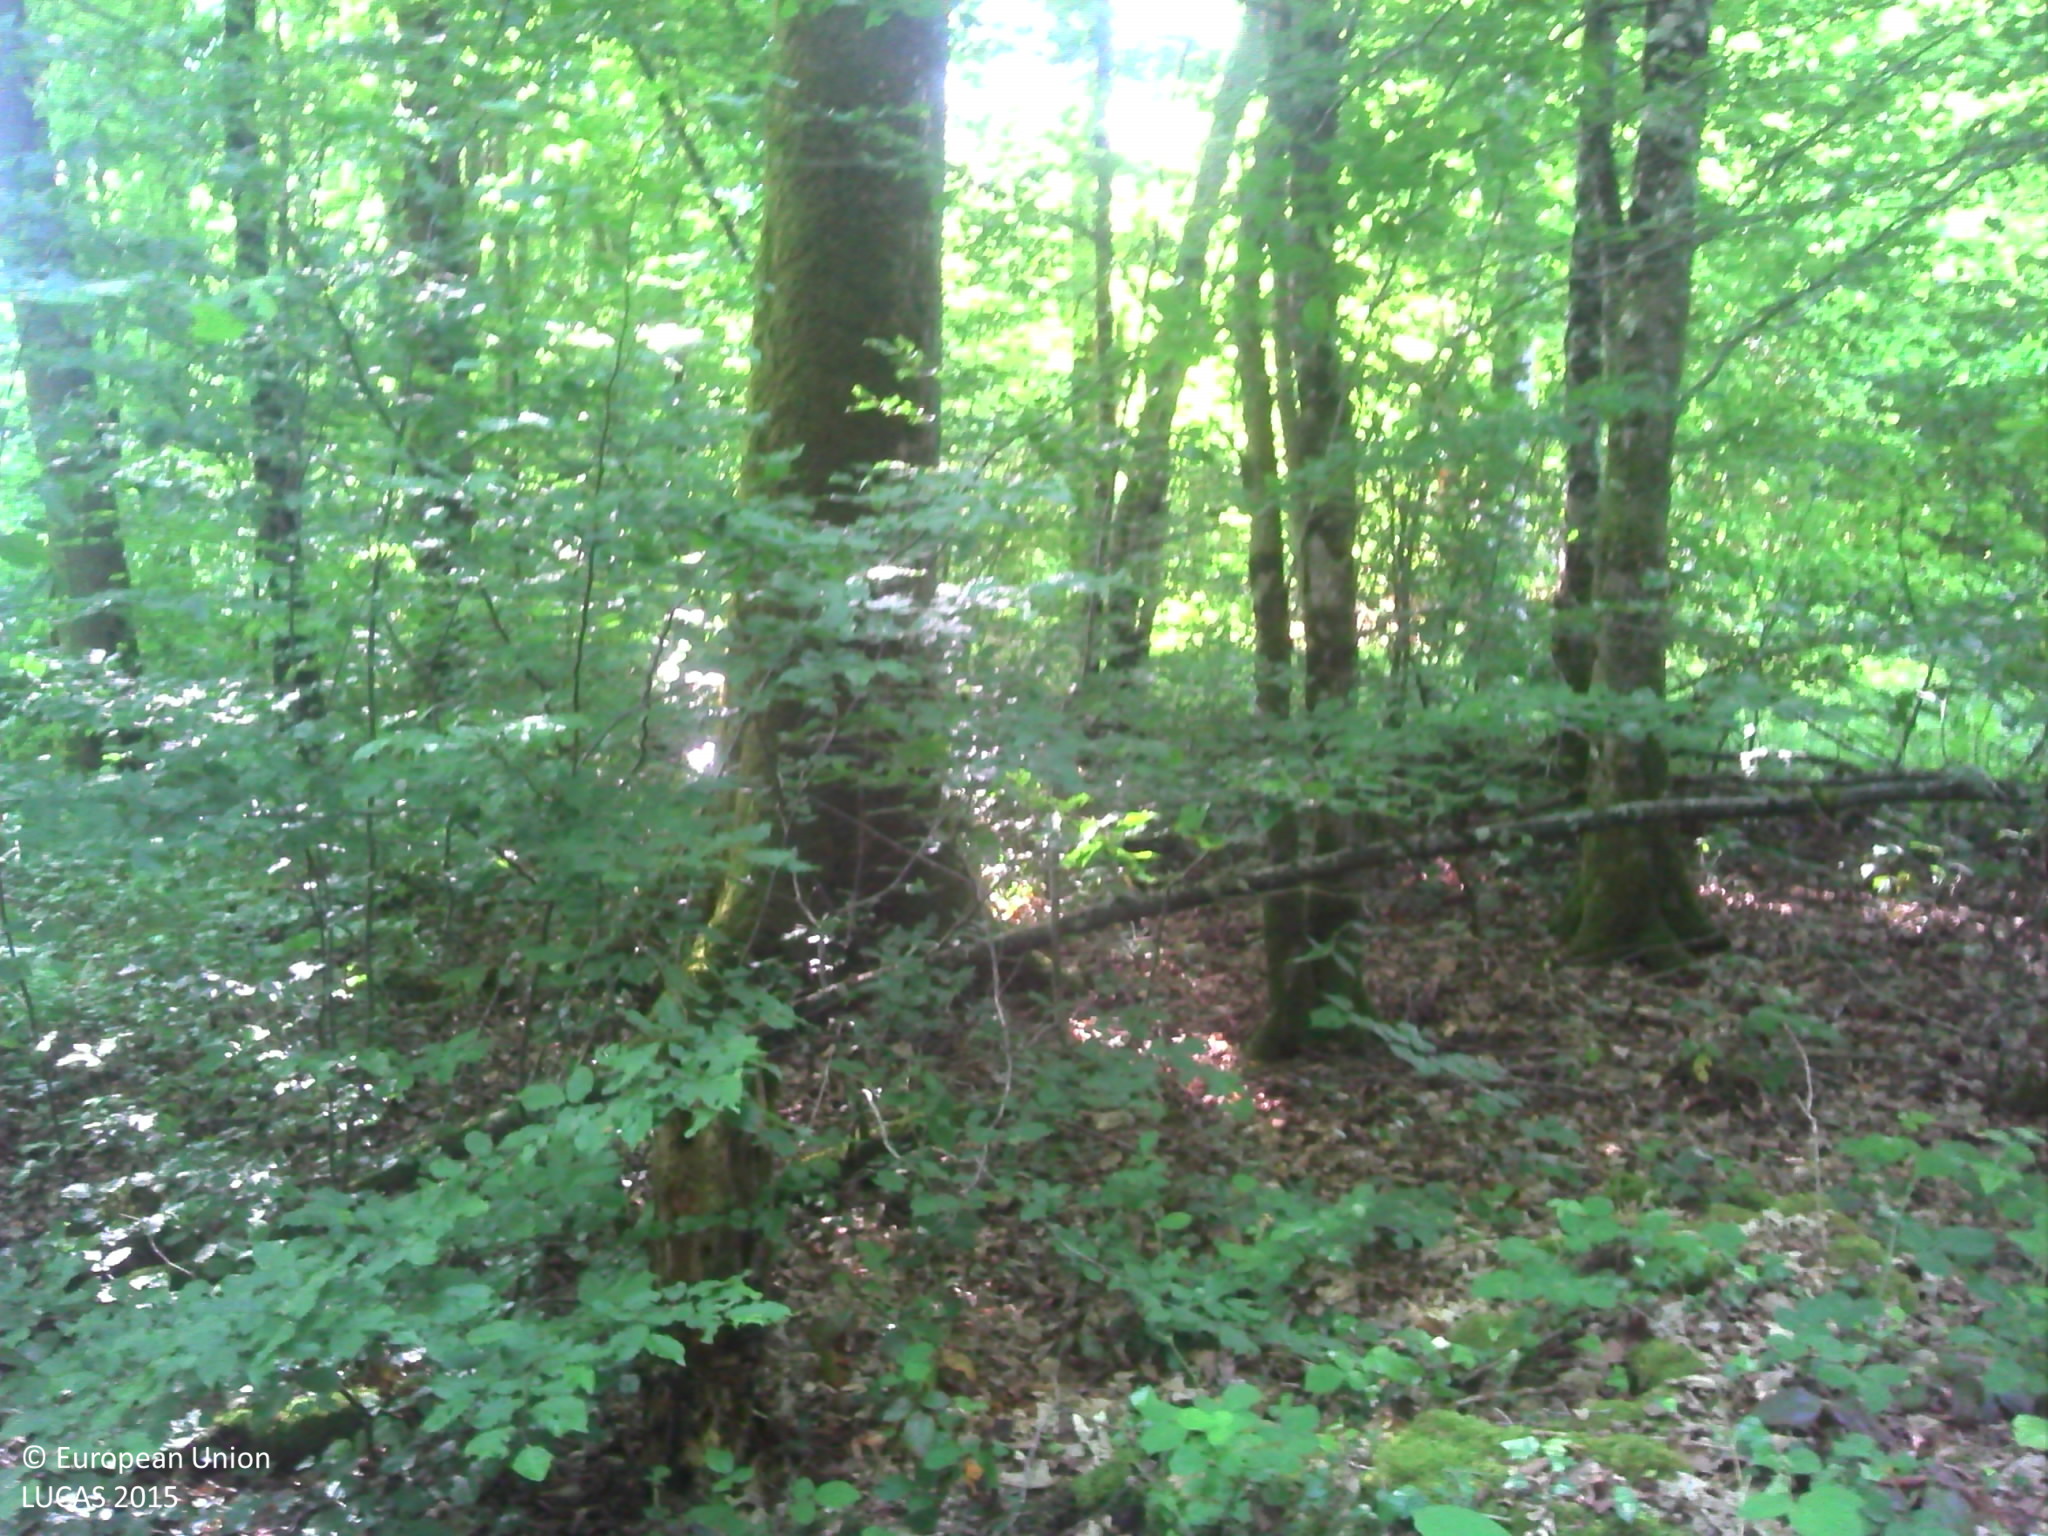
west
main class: Woodland
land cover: Broadleaved woodland
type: mesophytic deciduous forest
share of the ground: > 75 %
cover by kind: broadleaved forest trees 90 %, herbaceous plants 10 %
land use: Forestry
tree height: > 5 m
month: June
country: FR
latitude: 48.5546
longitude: 4.8633
